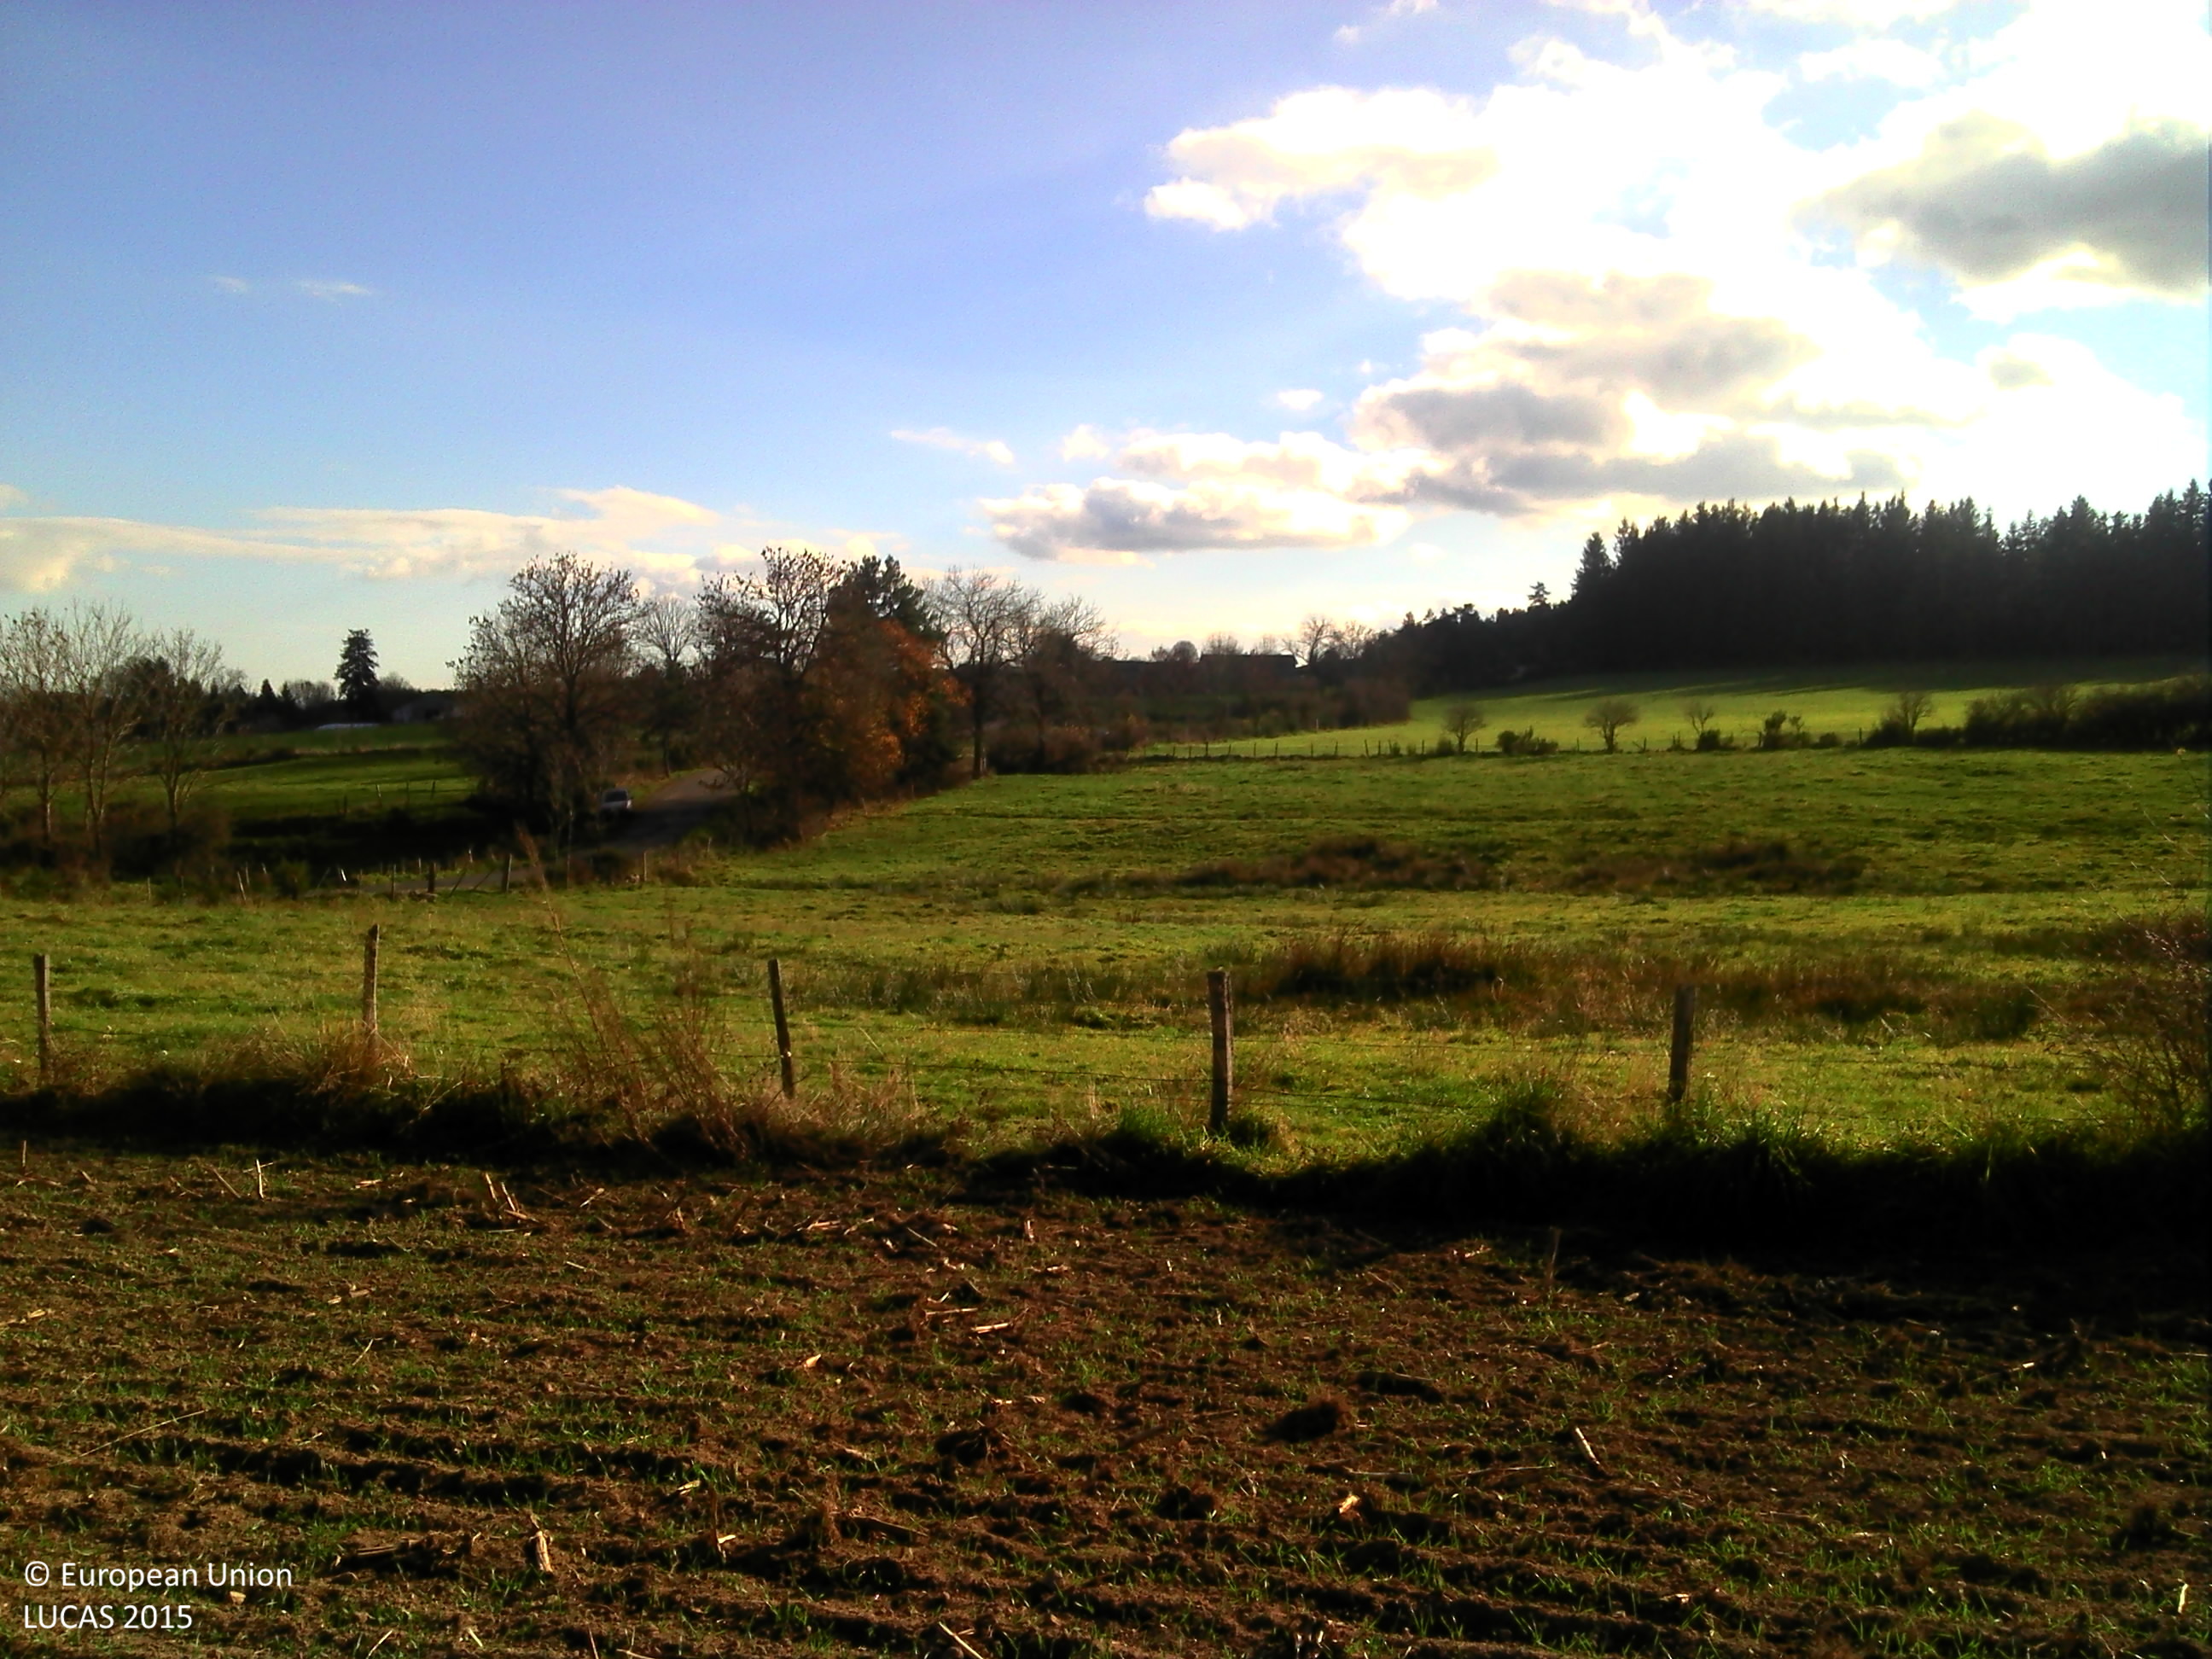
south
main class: Cropland
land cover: Temporary grasslands
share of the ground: 10 - 25 %
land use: Agriculture (excluding fallow land and kitchen gardens)
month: November
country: FR
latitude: 45.2498
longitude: 3.7983
